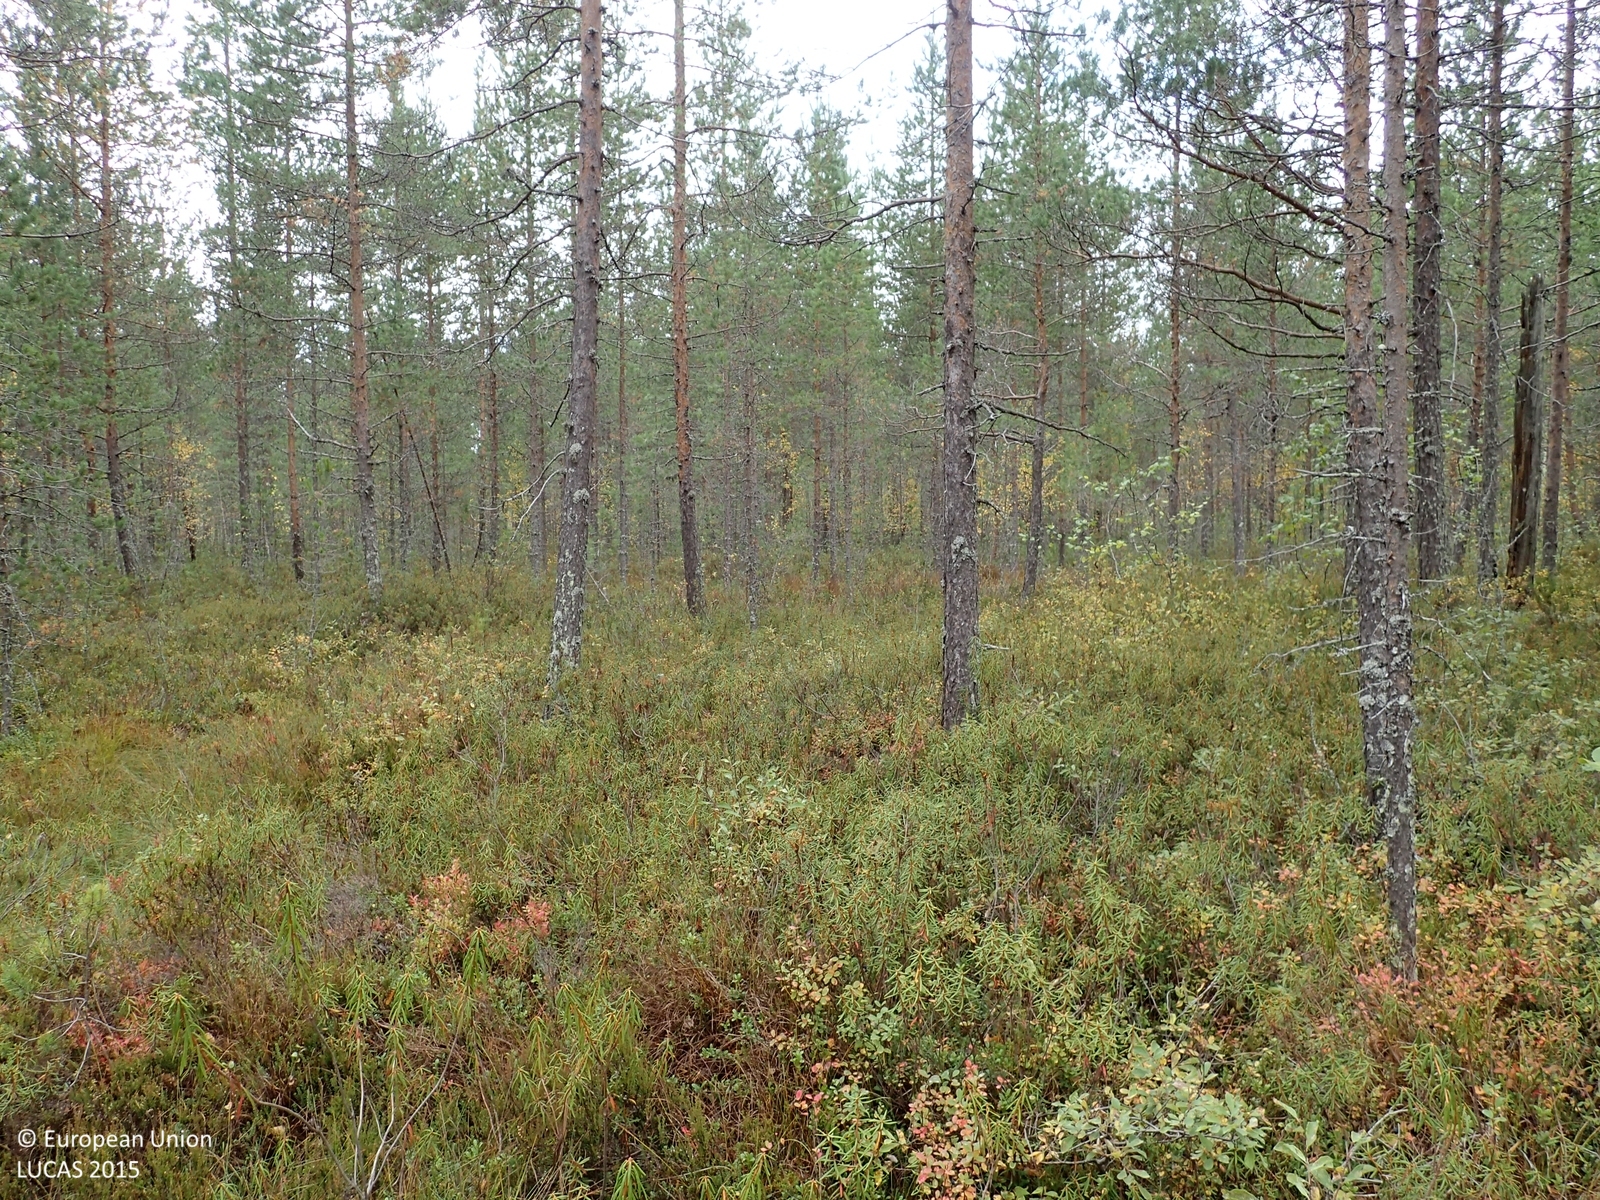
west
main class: Woodland
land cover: Pine dominated coniferous woodland
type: boreal forest
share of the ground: > 75 %
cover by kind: coniferous forest trees 70 %, shrubs 25 %, broadleaved forest trees 5 %
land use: Forestry
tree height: < 5 m
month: September
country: FI
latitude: 63.4586
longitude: 24.9942
